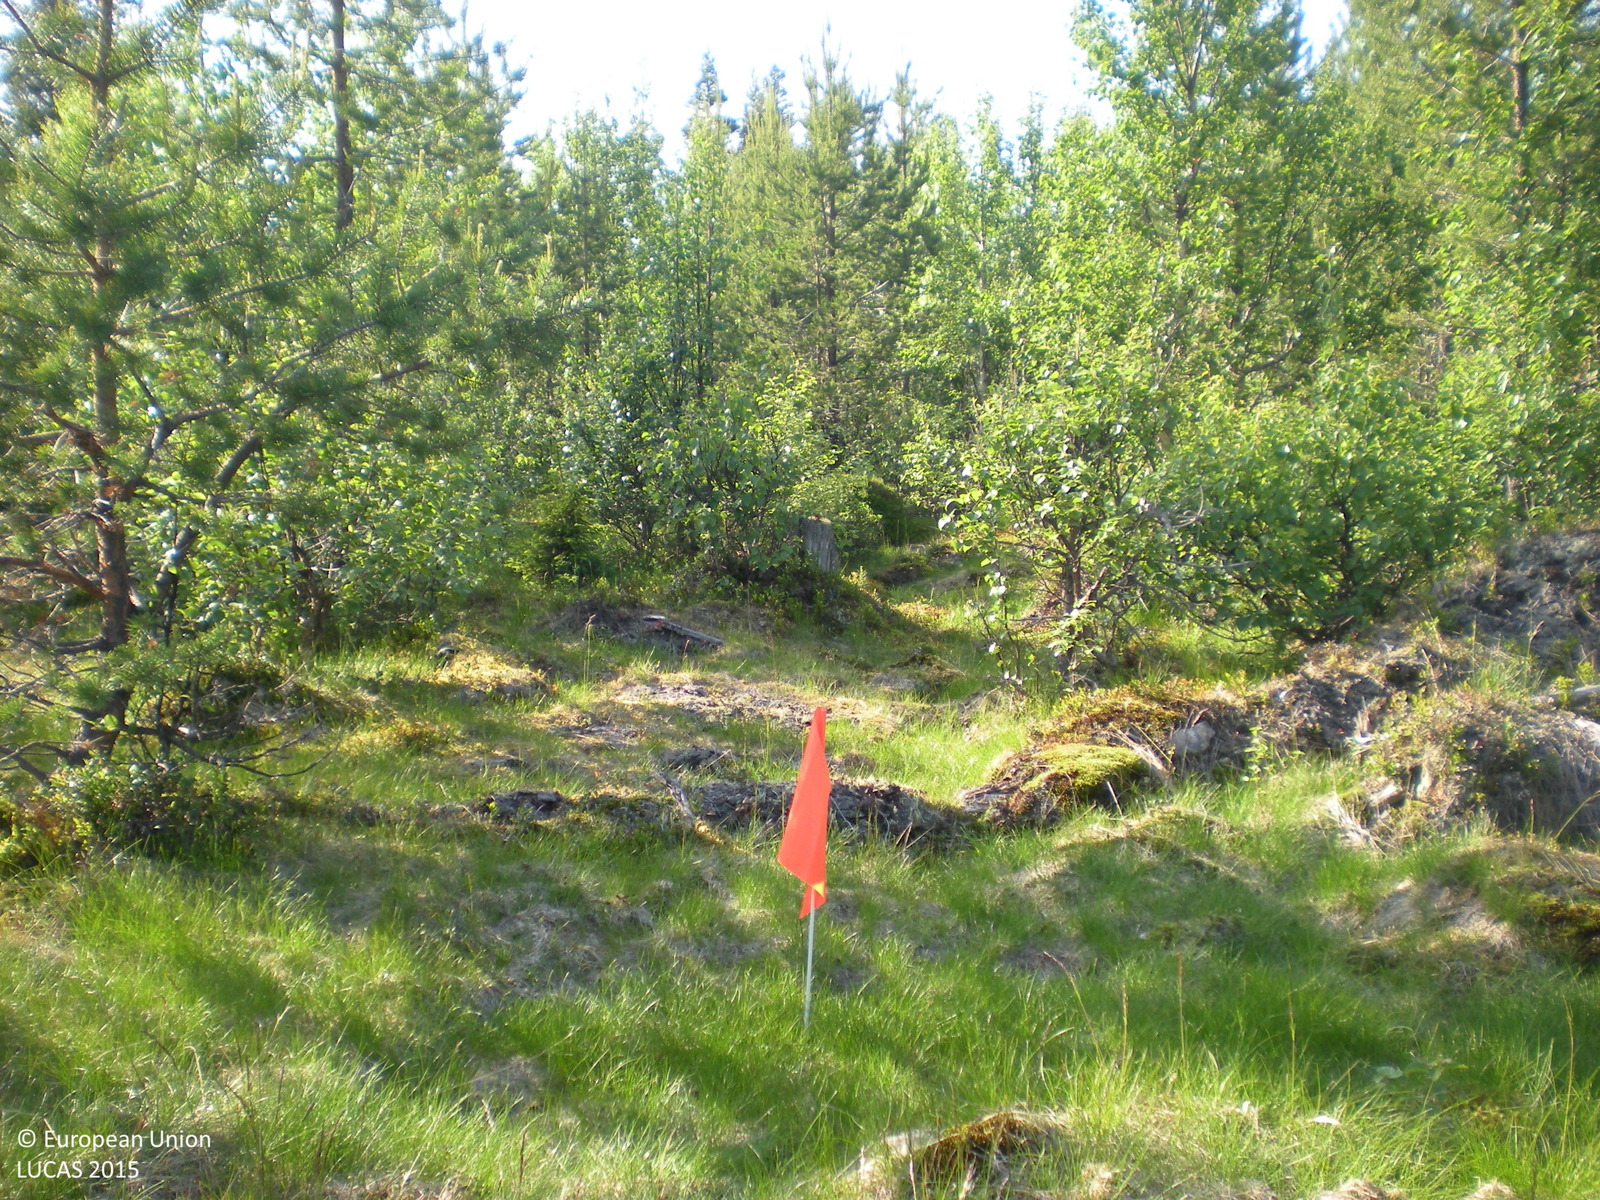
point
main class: Woodland
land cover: Pine dominated mixed woodland
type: boreal forest
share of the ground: 50 - 75 %
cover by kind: coniferous forest trees 30 %, herbaceous plants 30 %, broadleaved forest trees 25 %, shrubs 5 %, lichens and mosses 5 %, consolidated bare surface 5 %
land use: Forestry
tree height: < 5 m
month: July
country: SE
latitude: 65.4841
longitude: 17.6704
